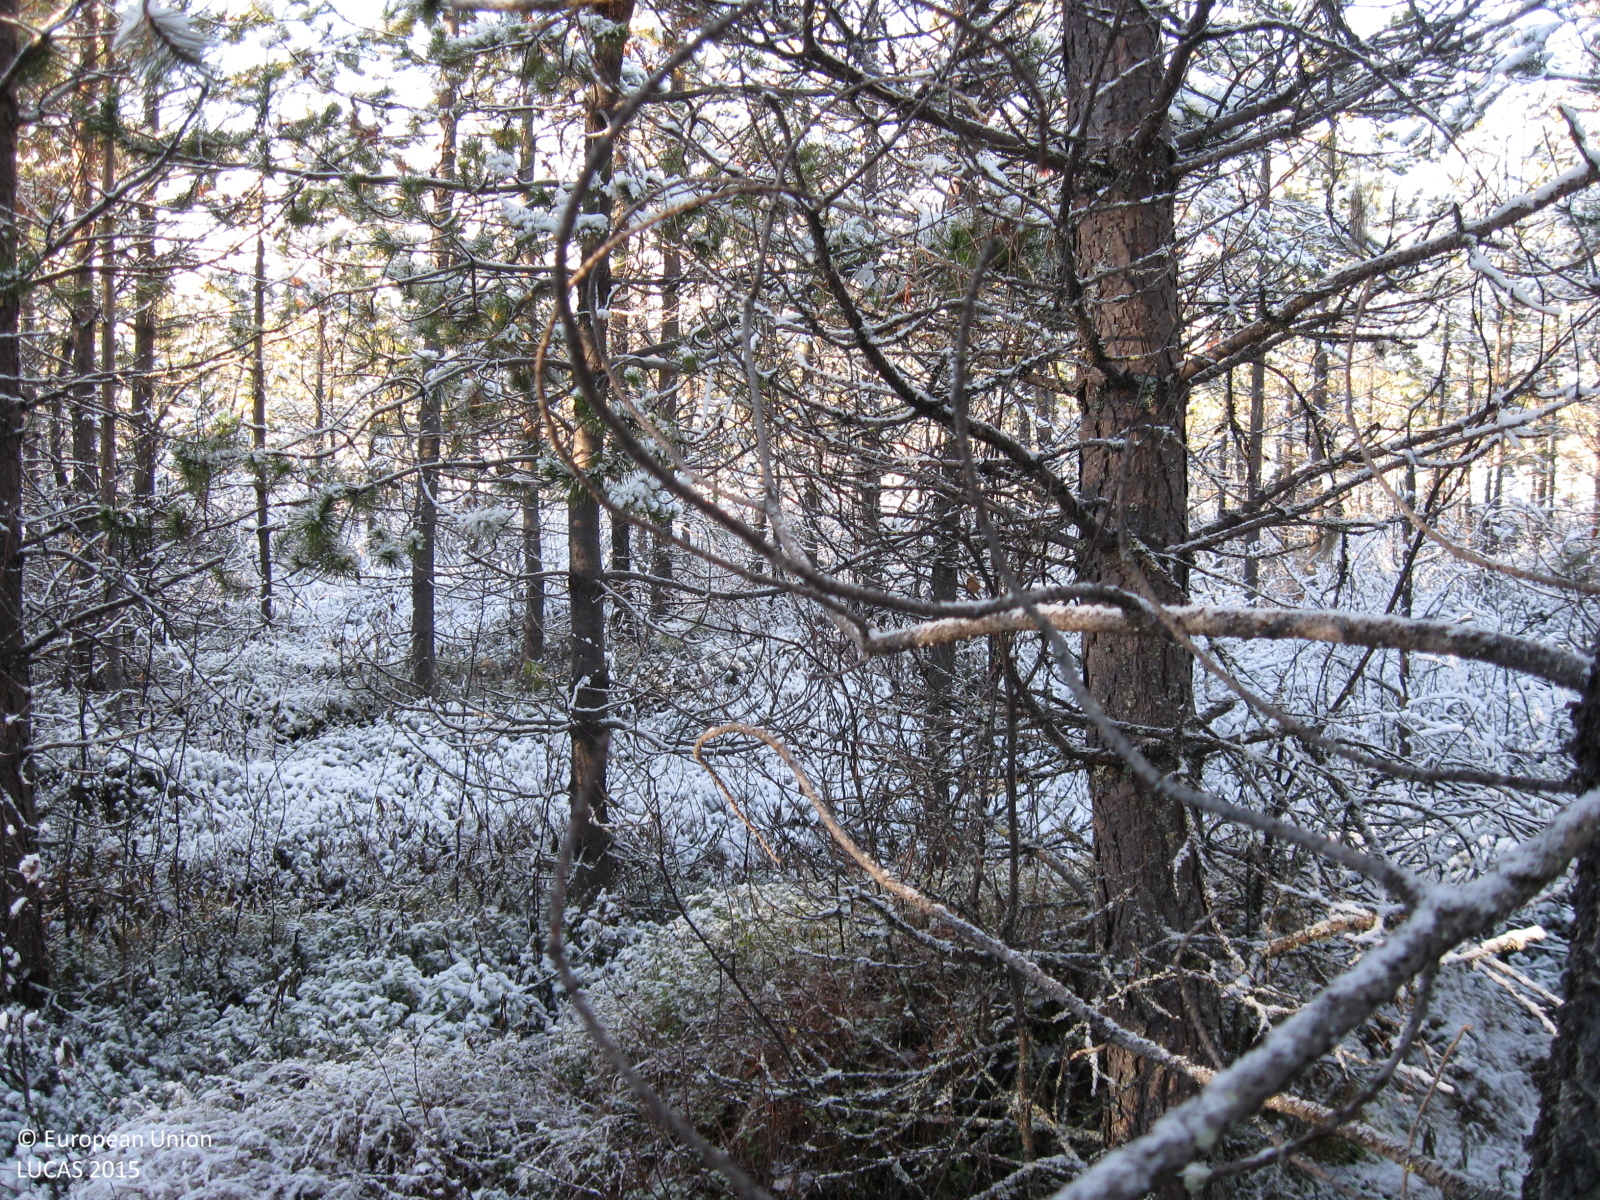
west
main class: Woodland
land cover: Pine dominated coniferous woodland
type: mire and swamp forests
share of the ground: > 75 %
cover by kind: coniferous forest trees 90 %, broadleaved forest trees 5 %, shrubs 5 %
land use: Forestry
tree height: > 5 m
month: October
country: SE
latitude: 66.4023
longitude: 21.4024
